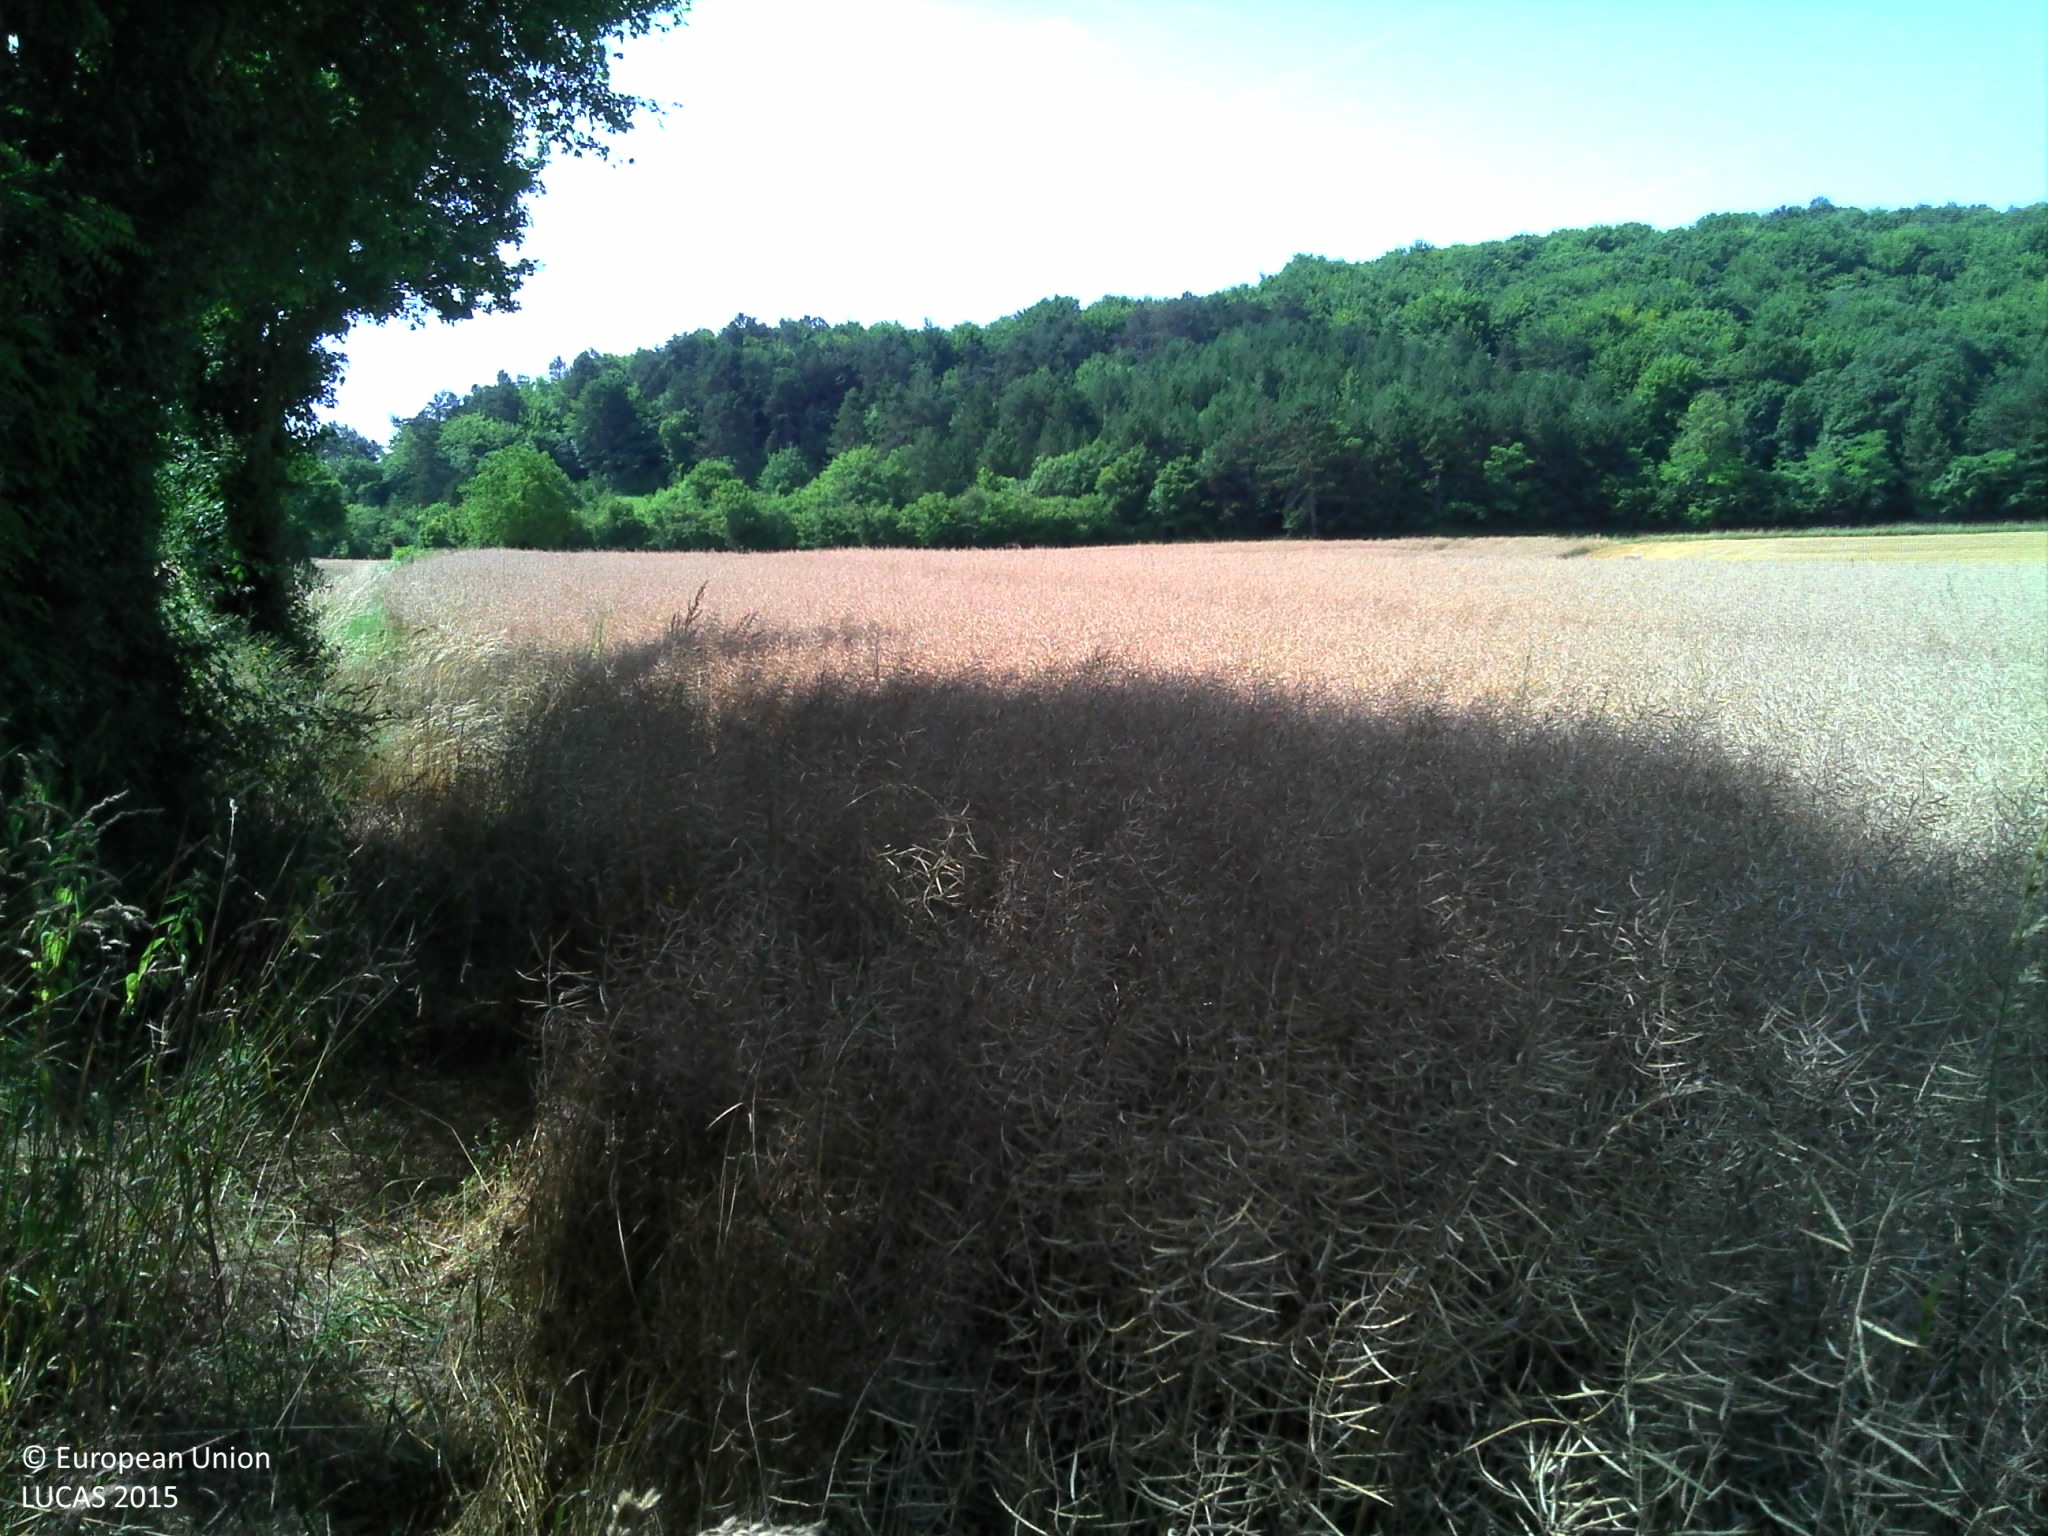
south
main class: Cropland
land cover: Rape and turnip rape
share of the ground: > 75 %
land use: Agriculture (excluding fallow land and kitchen gardens)
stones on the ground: < 10 %
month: July
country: FR
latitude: 47.3291
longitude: 3.5261
